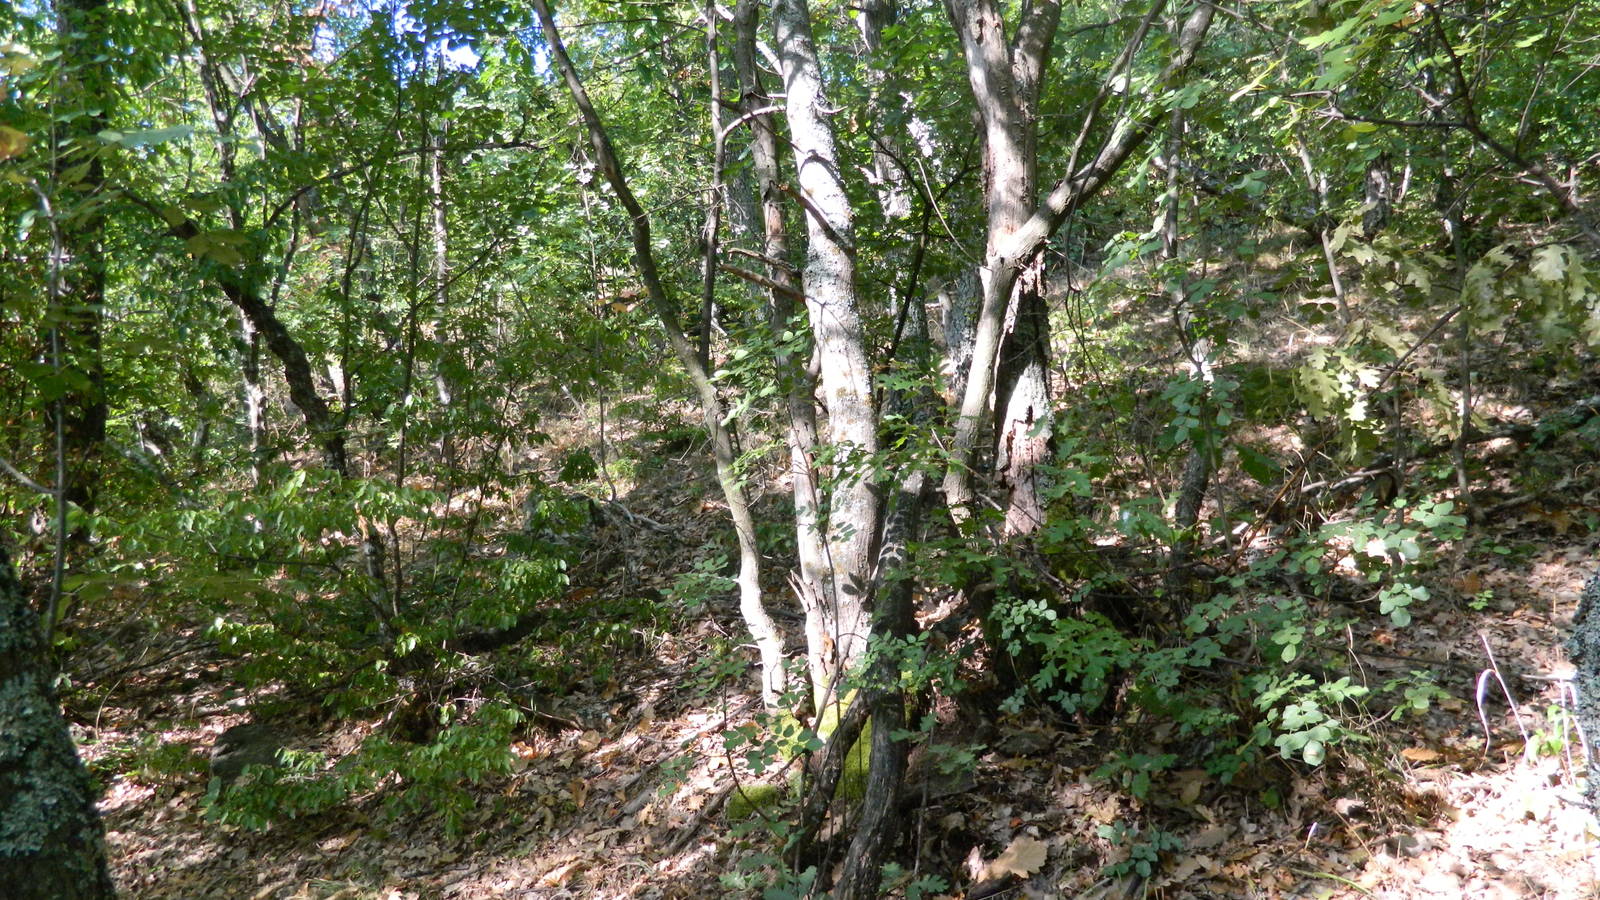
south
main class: Woodland
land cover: Broadleaved woodland
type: mesophytic deciduous forest
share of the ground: > 75 %
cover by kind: broadleaved forest trees 100 %
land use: Forestry
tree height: > 5 m
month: August
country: BG
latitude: 41.6566
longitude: 25.8334
